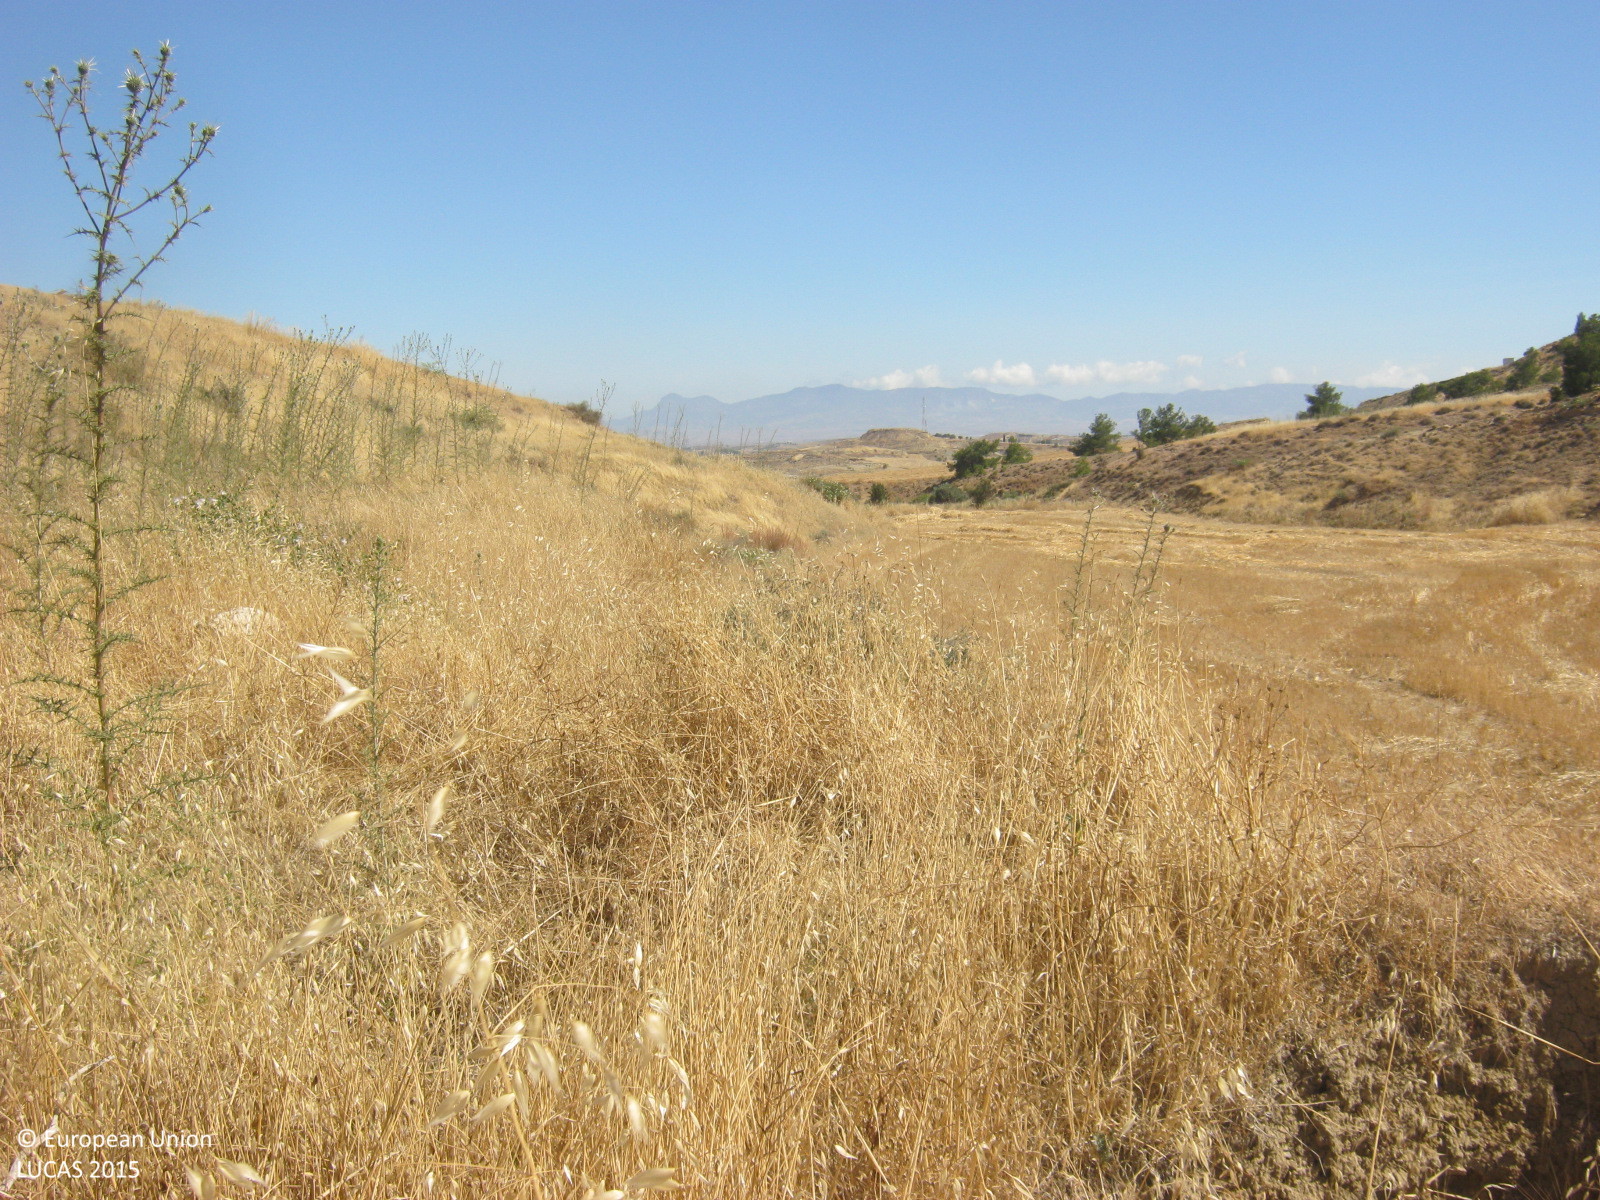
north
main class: Grassland
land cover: Spontaneously vegetated surfaces
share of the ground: > 75 %
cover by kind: herbaceous plants 85 %, unconsolidated bare surface 10 %, shrubs 5 %
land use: Semi-natural and natural areas not in use
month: June
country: CY
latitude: 35.0498
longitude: 33.1726
